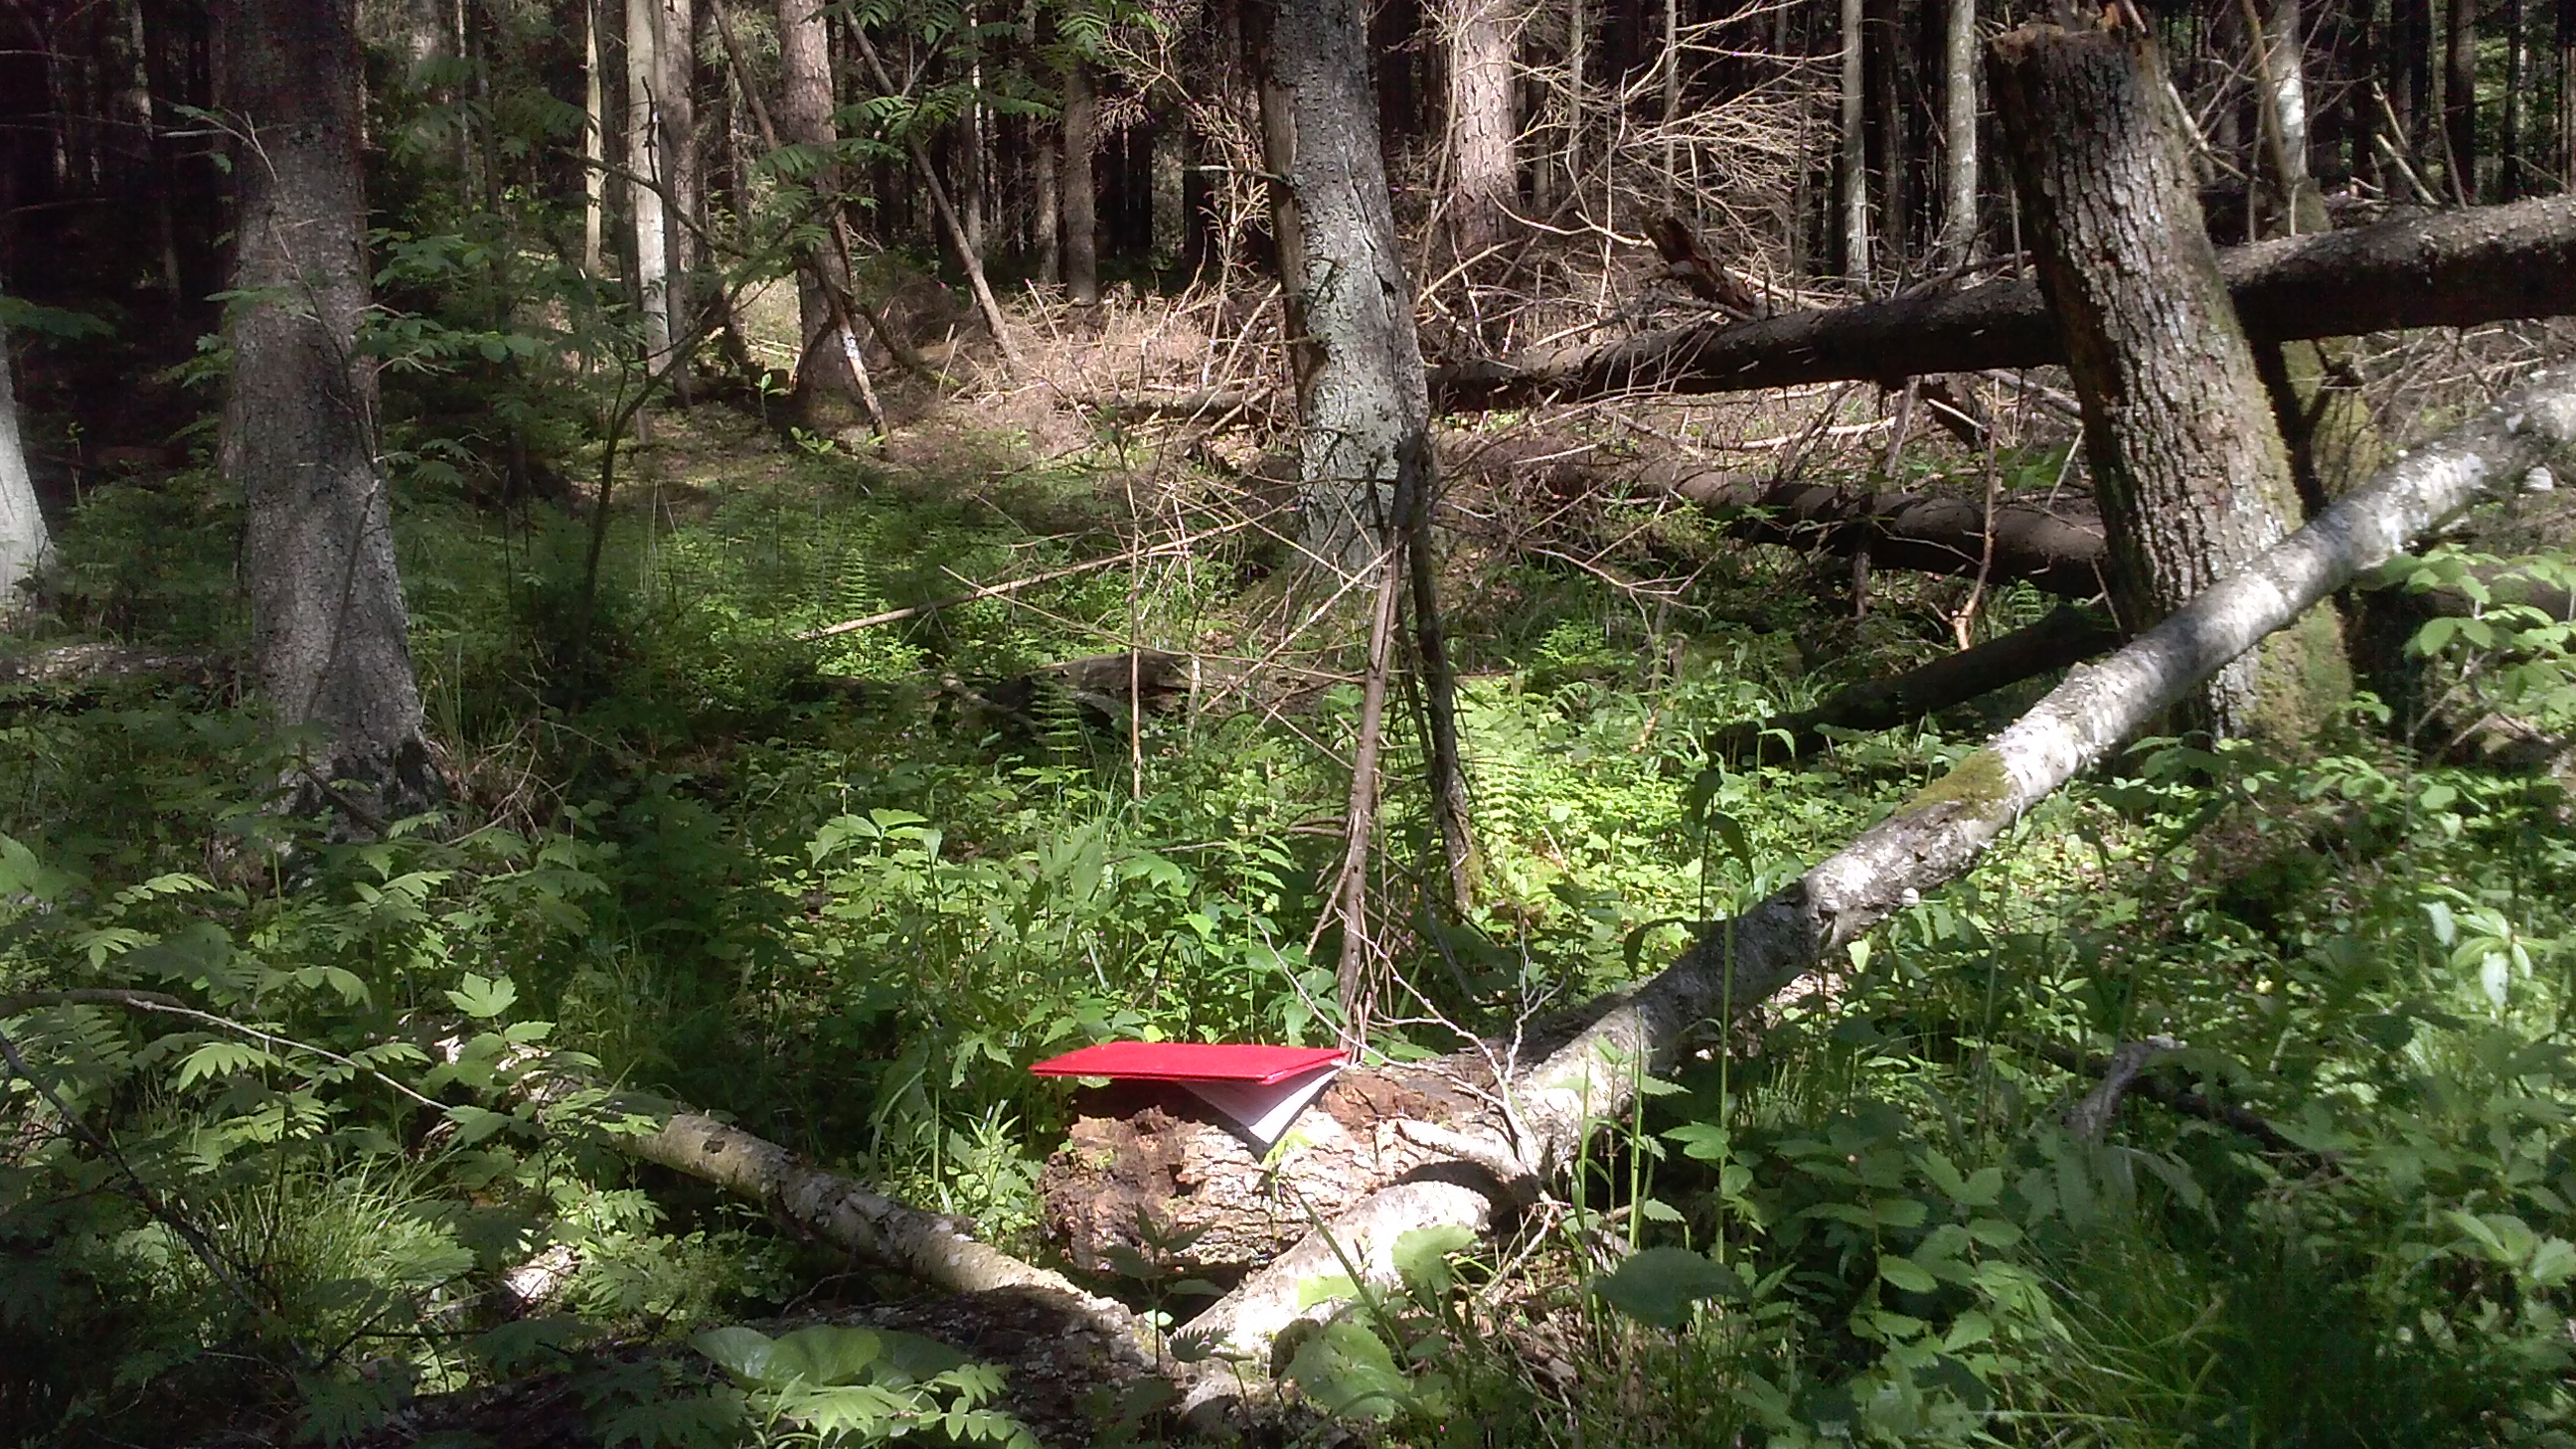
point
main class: Woodland
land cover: Spruce dominated coniferous woodland
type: hemiboreal forest and nemoral coniferous forest and mixed broadleaved-coniferous forest
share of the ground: > 75 %
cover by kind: coniferous forest trees 95 %, broadleaved forest trees 5 %
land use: Forestry
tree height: > 5 m
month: May
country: LV
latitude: 56.2835
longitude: 27.2126
